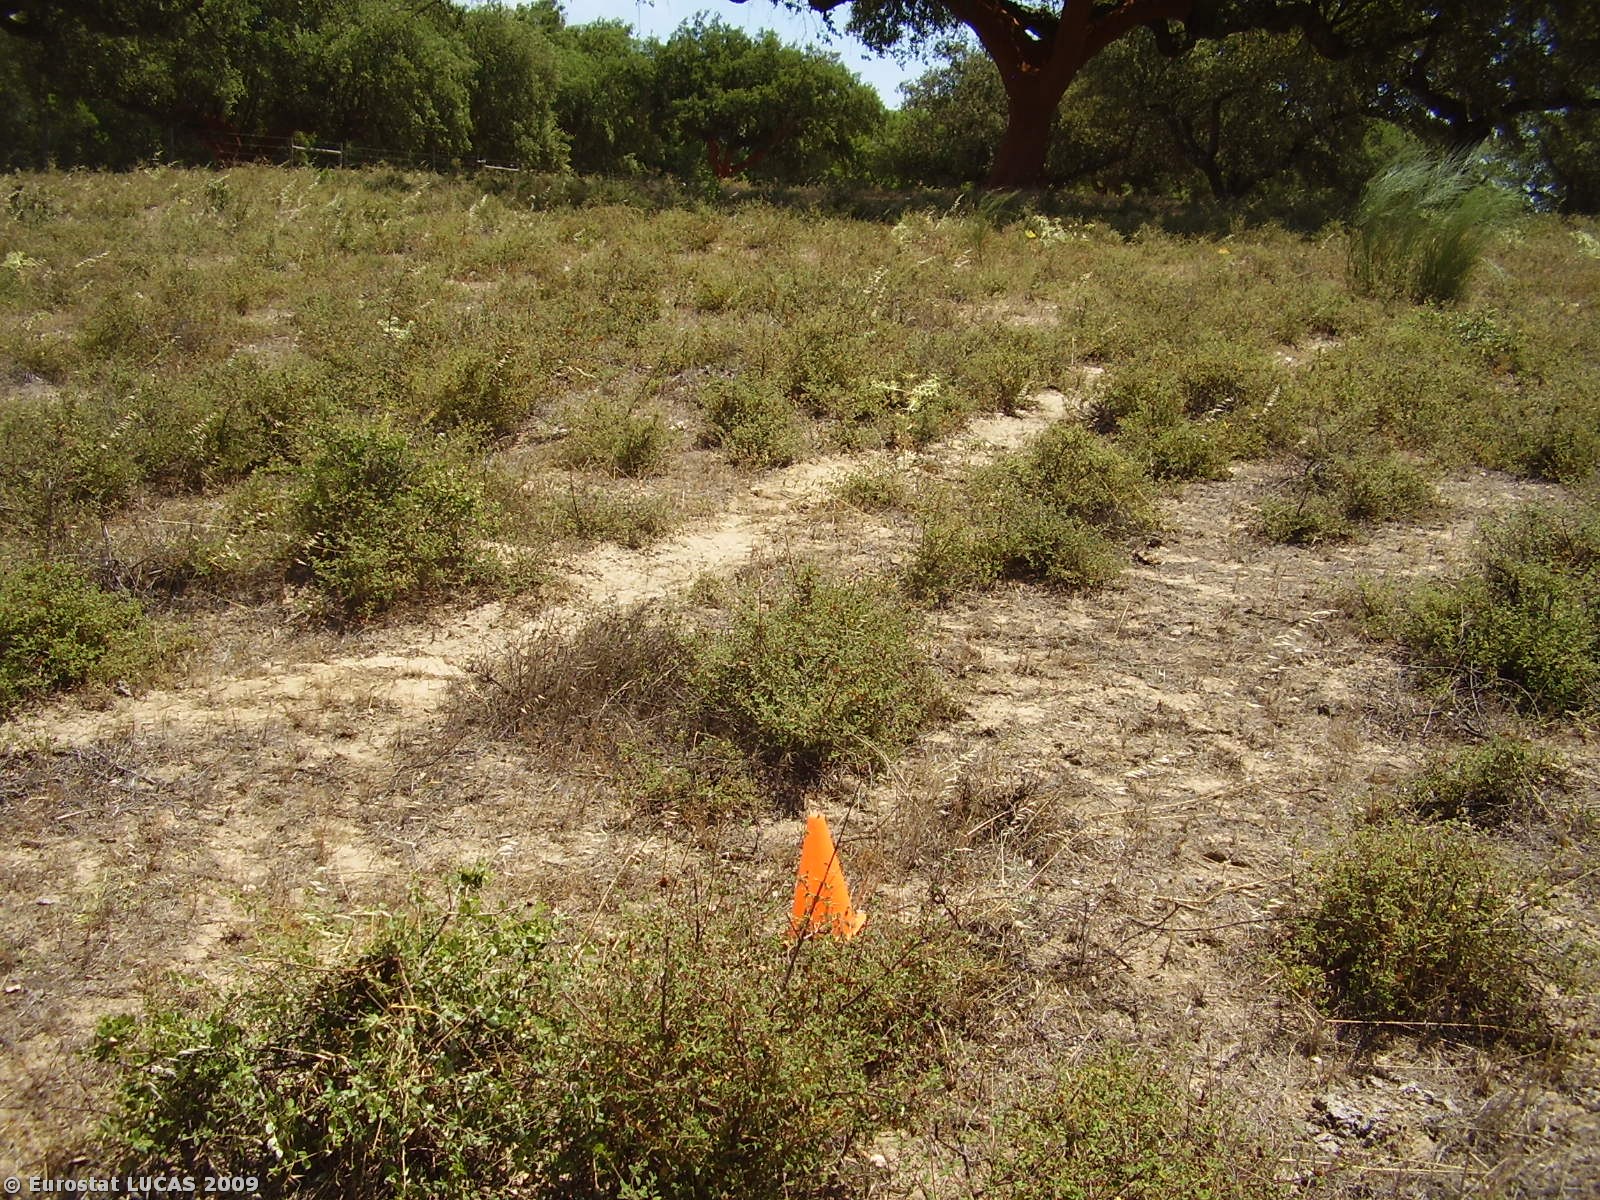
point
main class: Shrubland
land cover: Shrubland with sparse tree cover
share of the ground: > 75 %
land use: Fallow land
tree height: > 5 m
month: July
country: PT
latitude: 38.7029
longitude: -7.8758
